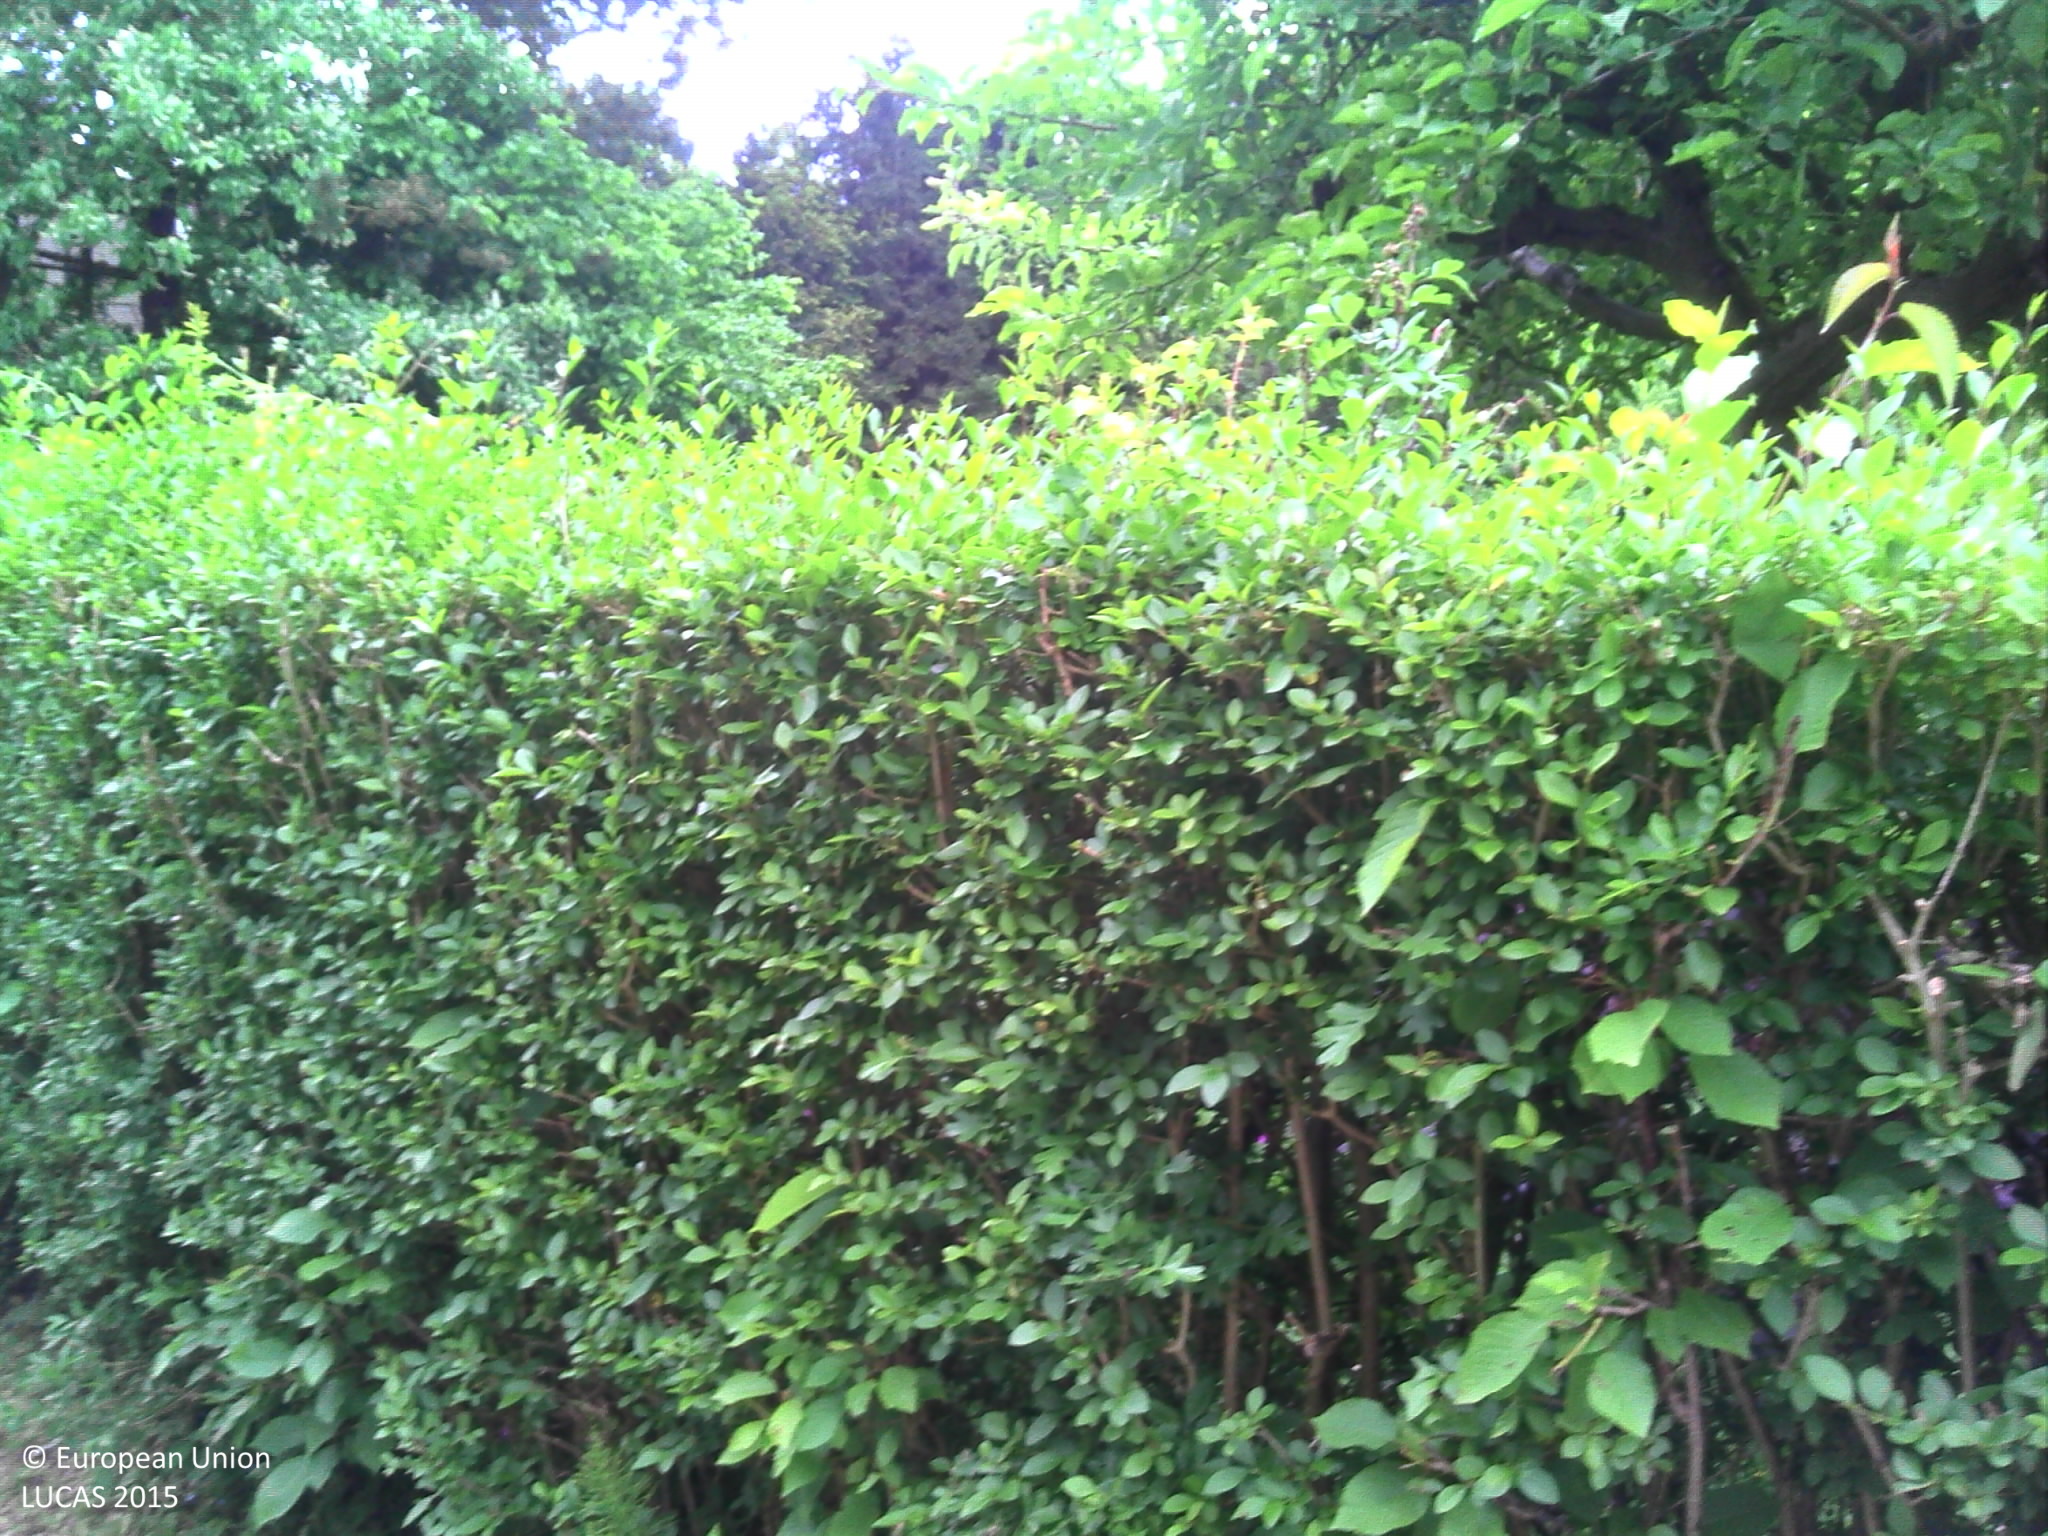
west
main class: Grassland
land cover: Grassland with sparse tree/shrub cover
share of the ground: > 75 %
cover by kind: herbaceous plants 95 %, broadleaved forest trees 5 %
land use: Residential
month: May
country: BE
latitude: 50.7177
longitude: 4.4861
